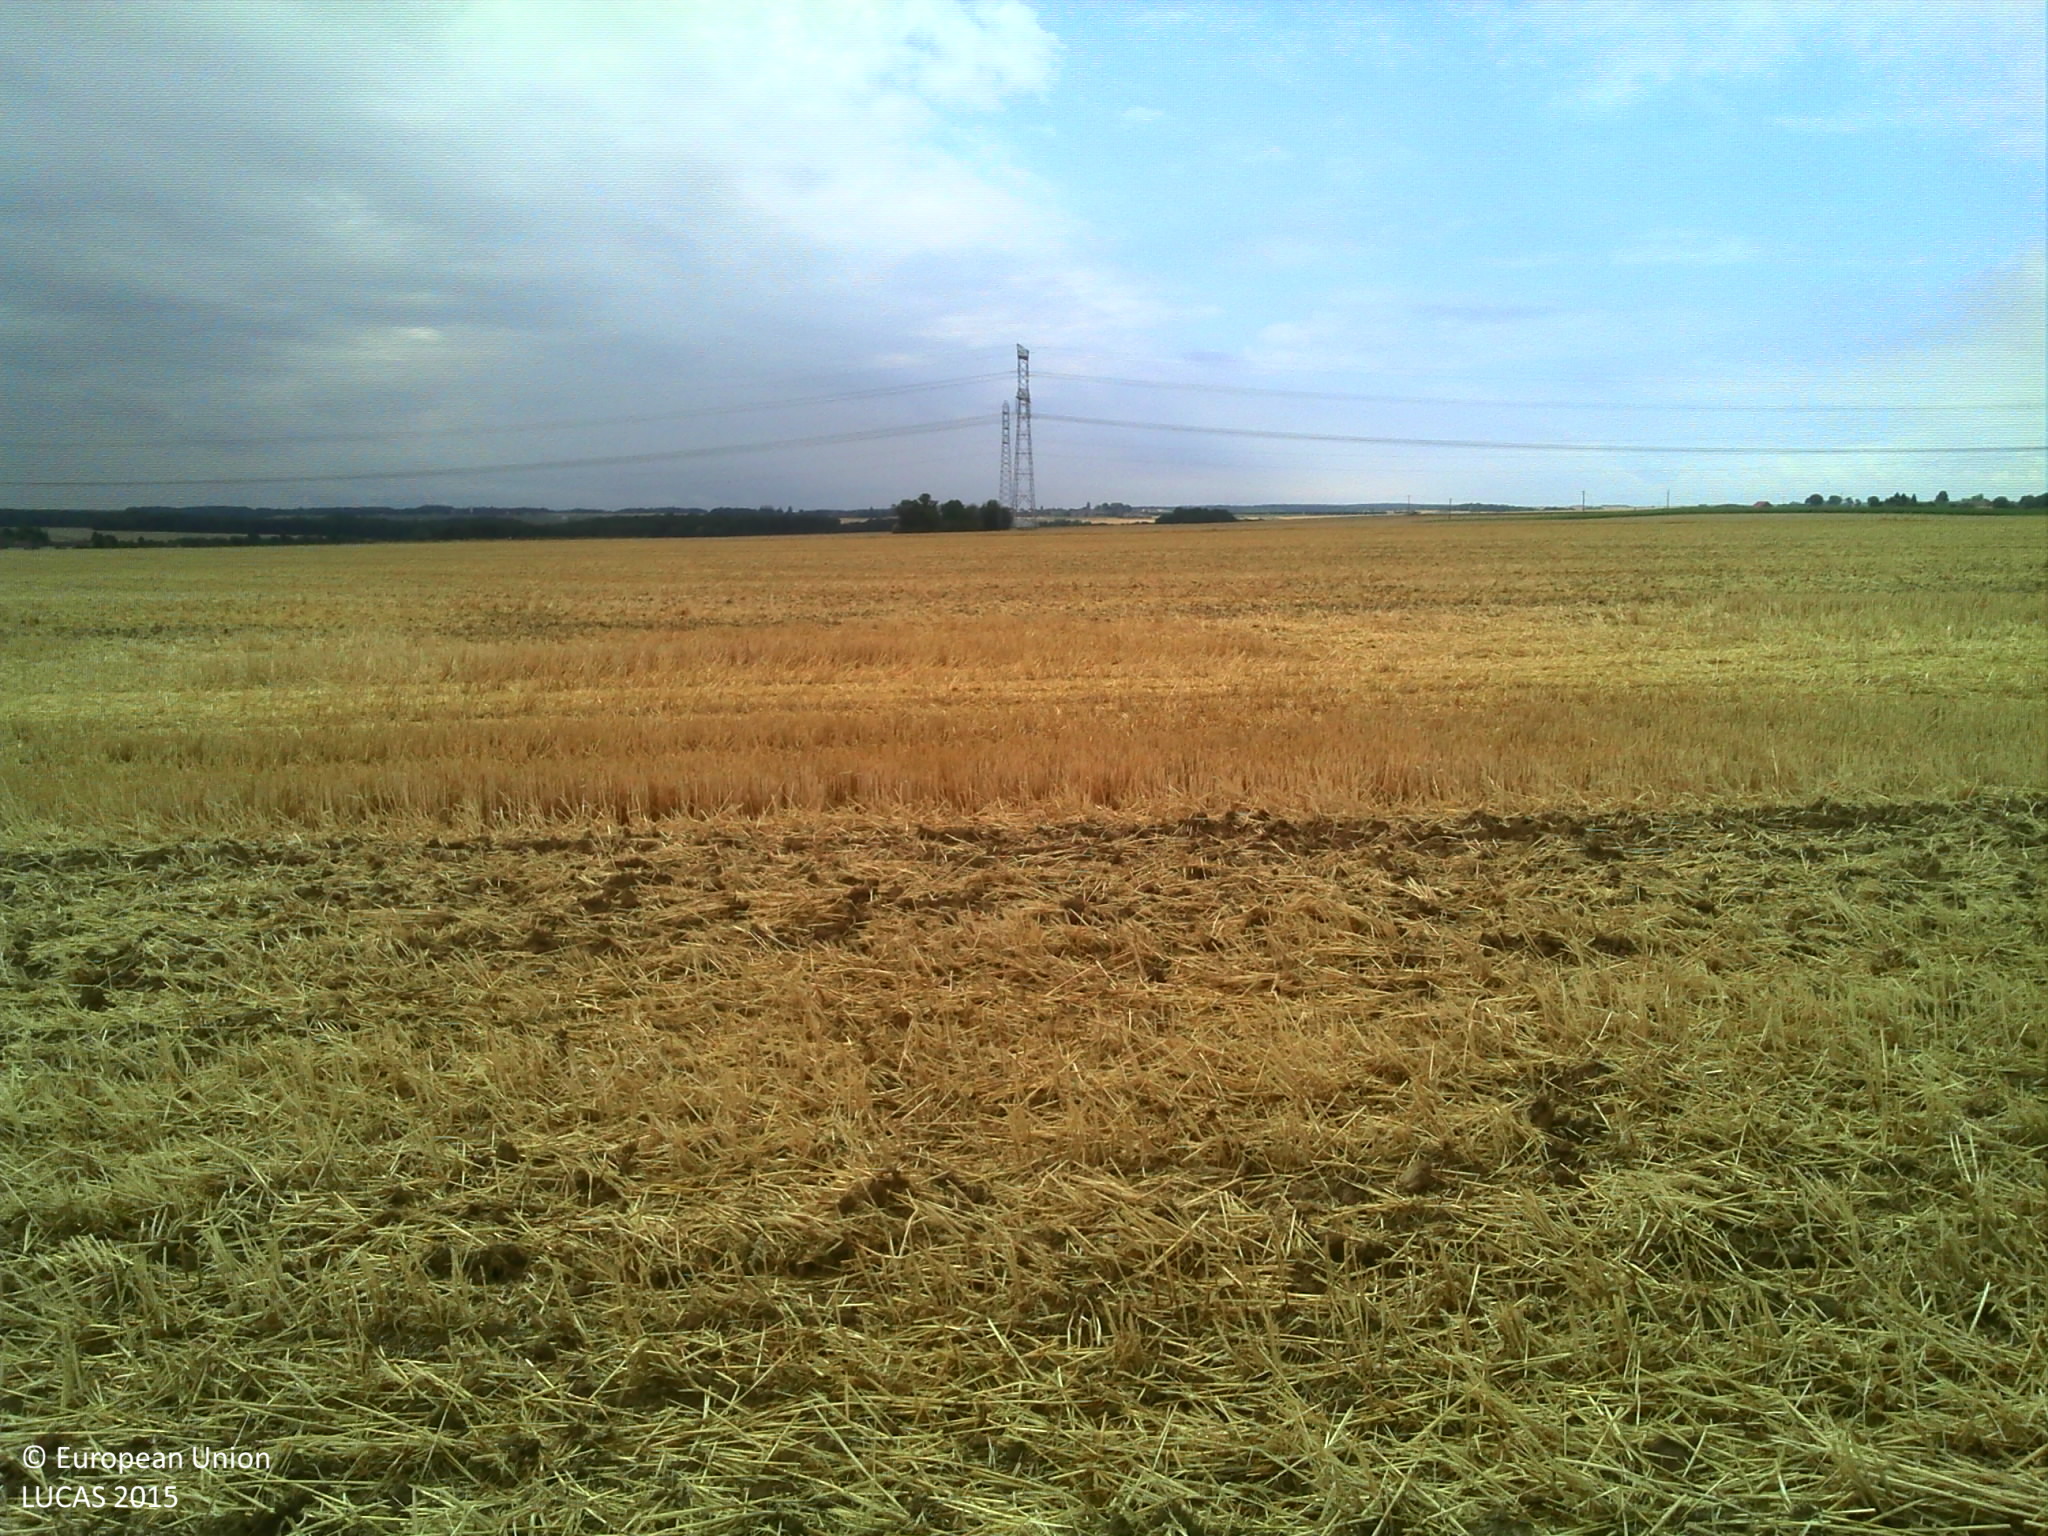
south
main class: Cropland
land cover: Common wheat
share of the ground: > 75 %
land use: Agriculture (excluding fallow land and kitchen gardens)
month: August
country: FR
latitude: 48.5832
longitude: 3.3645
